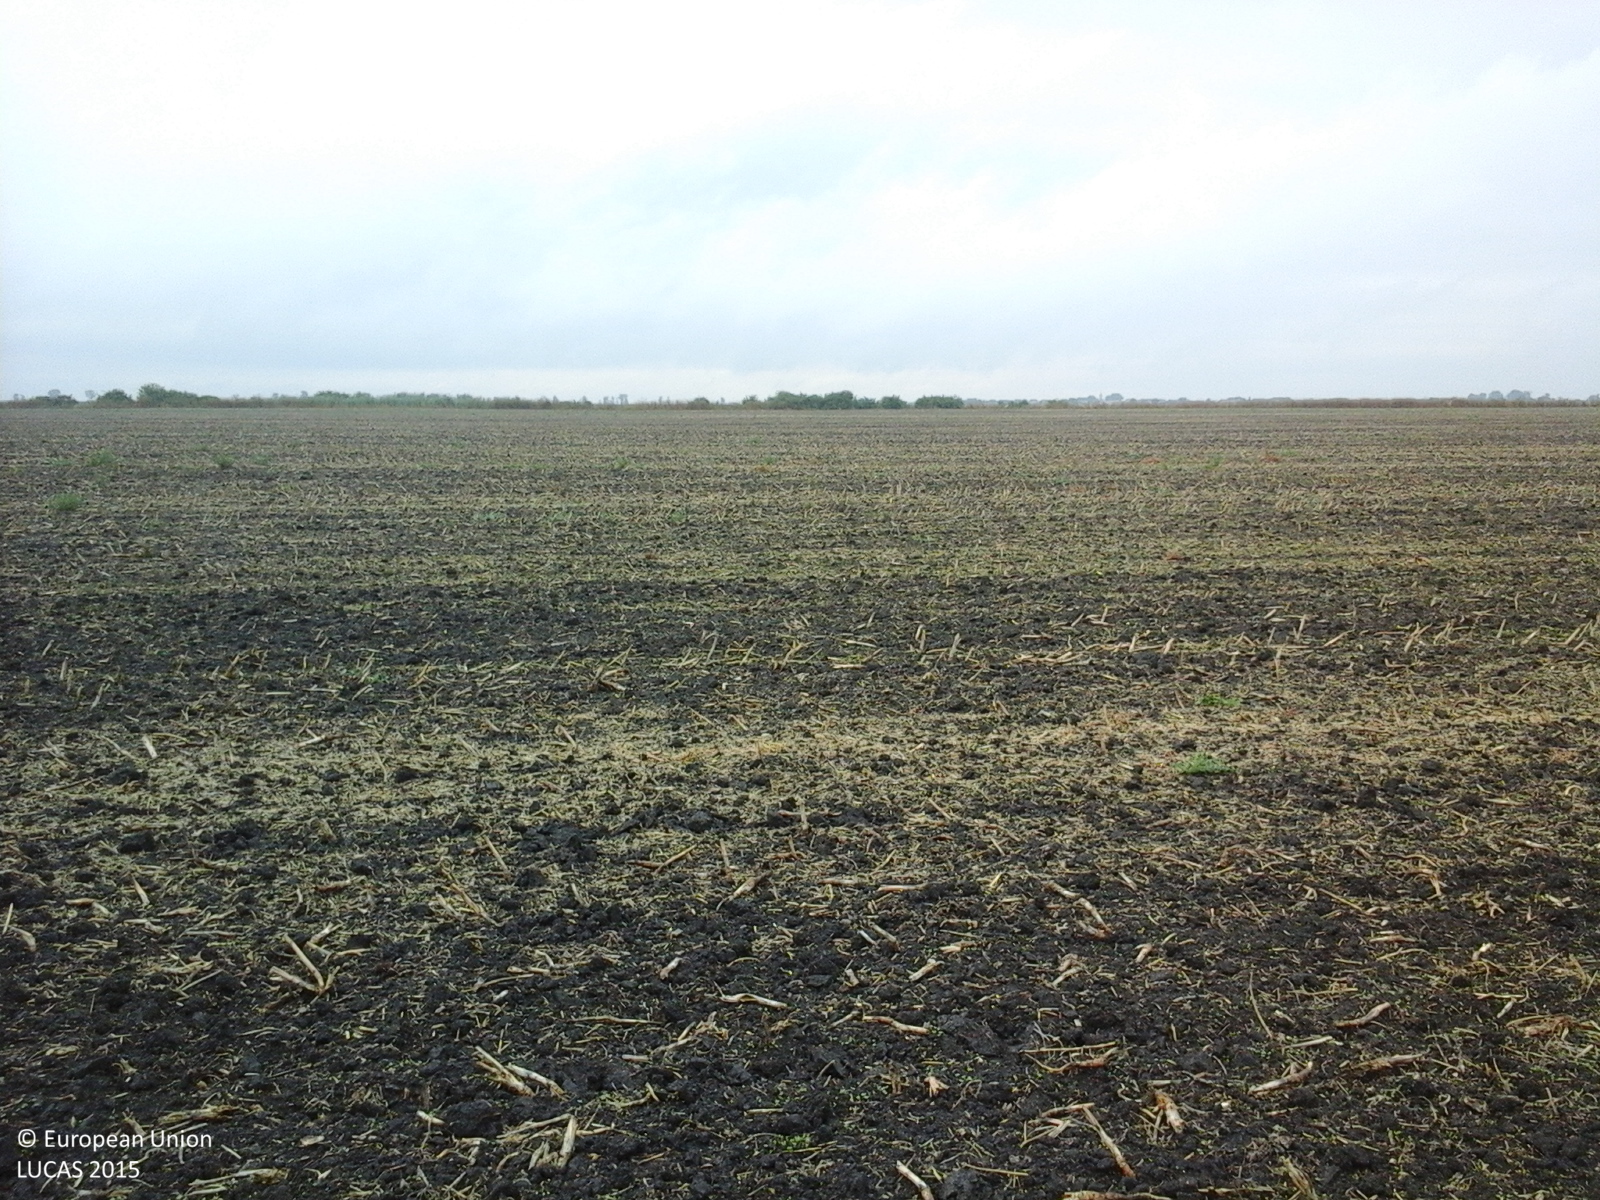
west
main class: Cropland
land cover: Rape and turnip rape
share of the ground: < 10 %
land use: Agriculture (excluding fallow land and kitchen gardens)
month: August
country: RO
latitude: 45.8492
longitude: 20.7008
